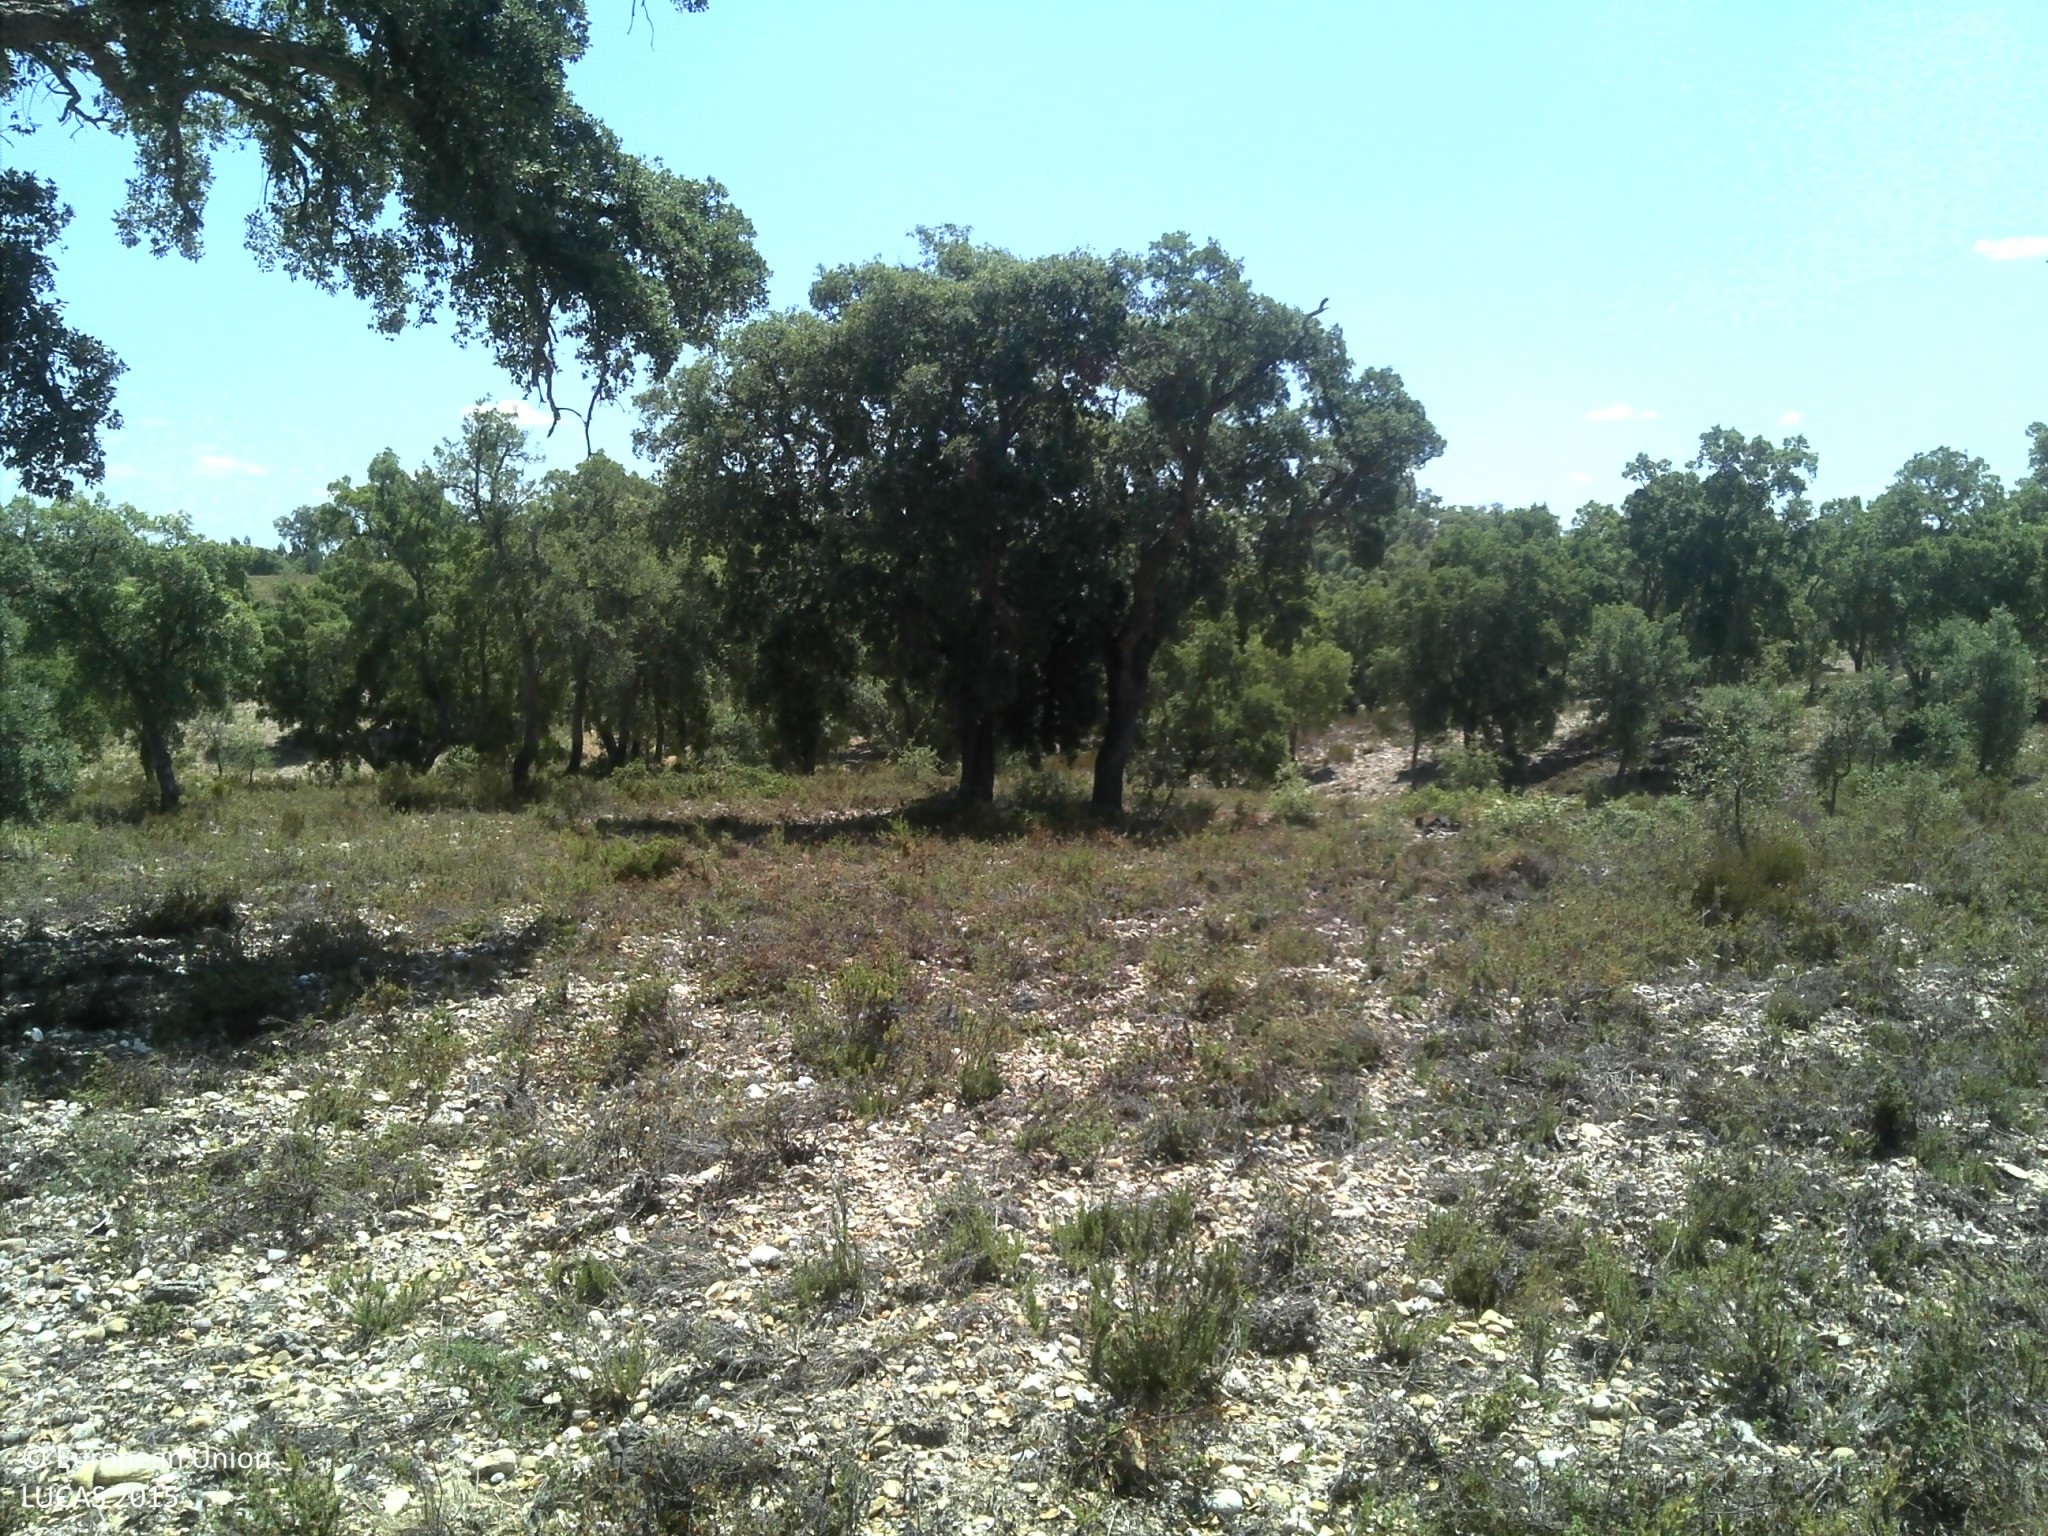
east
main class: Woodland
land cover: Broadleaved woodland
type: broadleaved evergreen forest
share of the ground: 10 - 25 %
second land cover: Grassland without tree/shrub cover
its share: 25 - 50 %
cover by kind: unconsolidated bare surface 40 %, broadleaved forest trees 25 %, herbaceous plants 25 %, shrubs 10 %
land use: Forestry
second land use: Agriculture (excluding fallow land and kitchen gardens)
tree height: > 5 m
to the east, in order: Broadleaved woodland; Grassland without tree/shrub cover; Broadleaved woodland; Fences; Grass margins; Tracks; Broadleaved woodland; Grassland with sparse tree/shrub cover
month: June
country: PT
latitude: 39.2834
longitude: -8.3227
